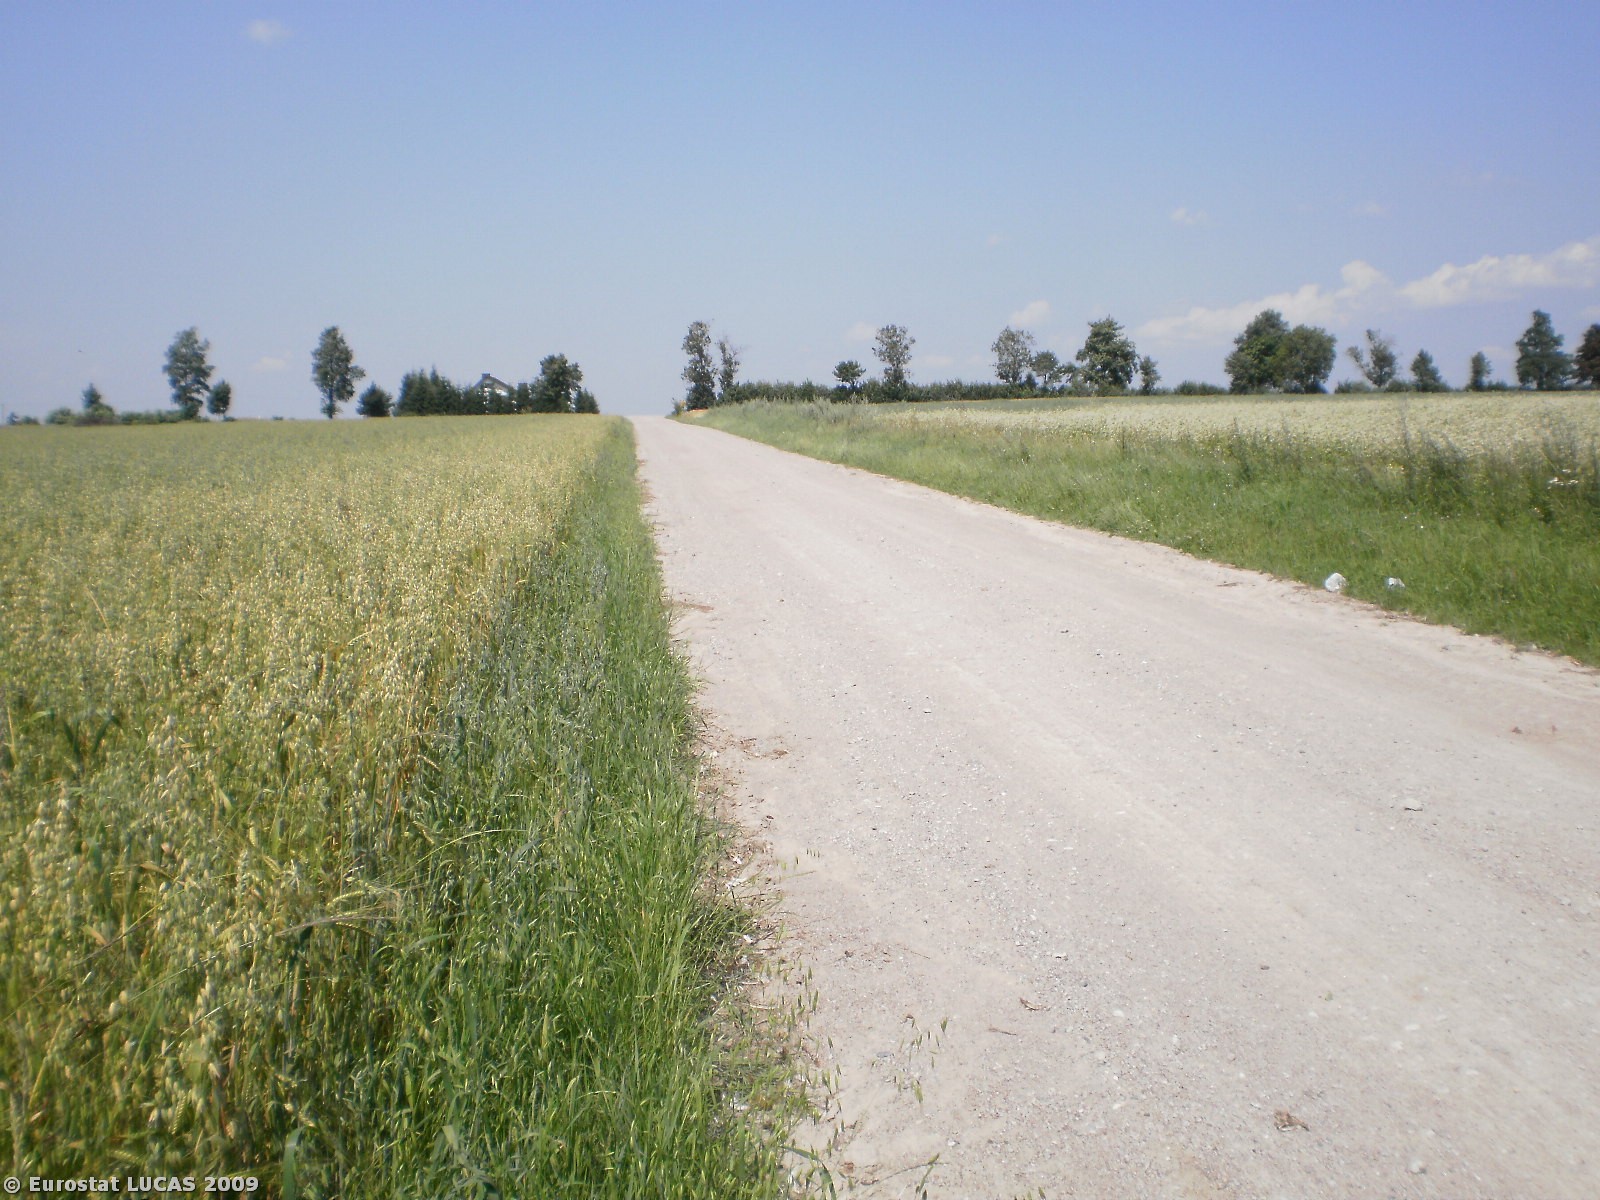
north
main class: Cropland
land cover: Mixed cereals for fodder
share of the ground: > 75 %
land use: Agriculture (excluding fallow land and kitchen gardens)
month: July
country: PL
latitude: 53.3529
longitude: 20.3873
